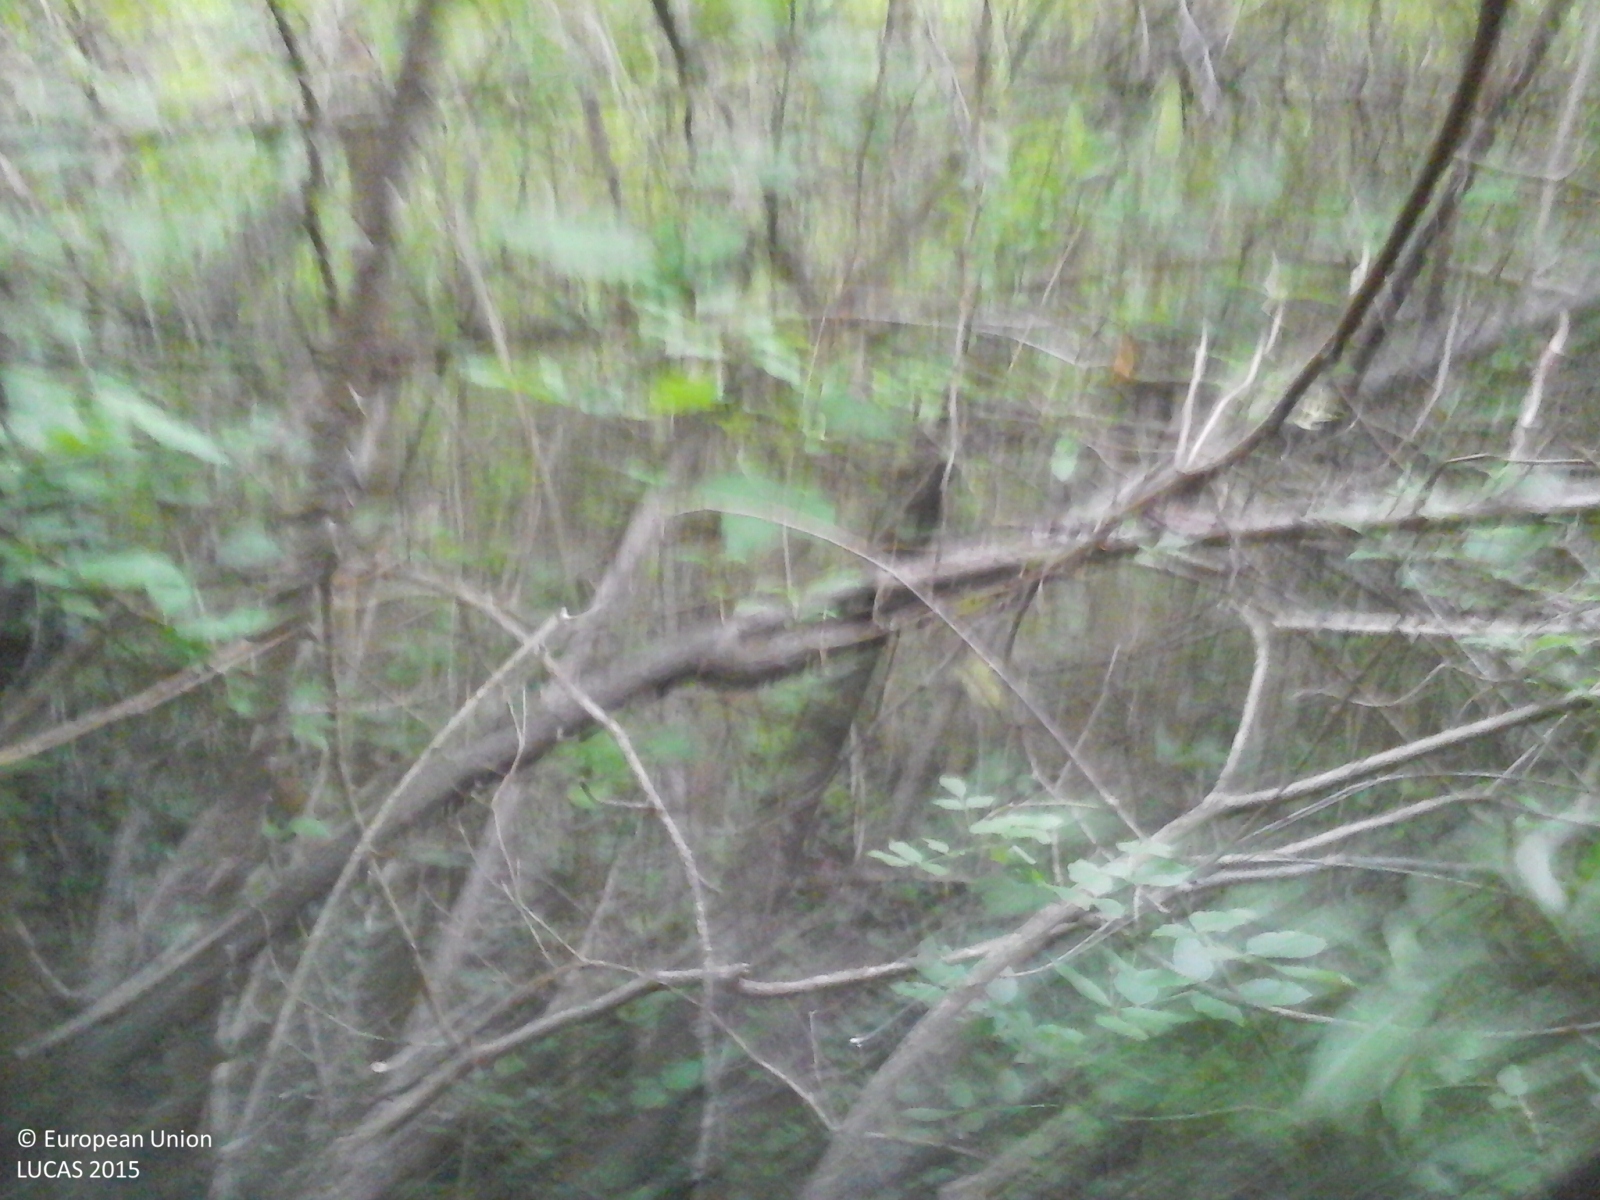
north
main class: Woodland
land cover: Broadleaved woodland
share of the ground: > 75 %
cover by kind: shrubs 60 %, broadleaved forest trees 40 %
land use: Semi-natural and natural areas not in use
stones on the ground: 10 - 25 %
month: May
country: IT
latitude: 45.8775
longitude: 11.0678
